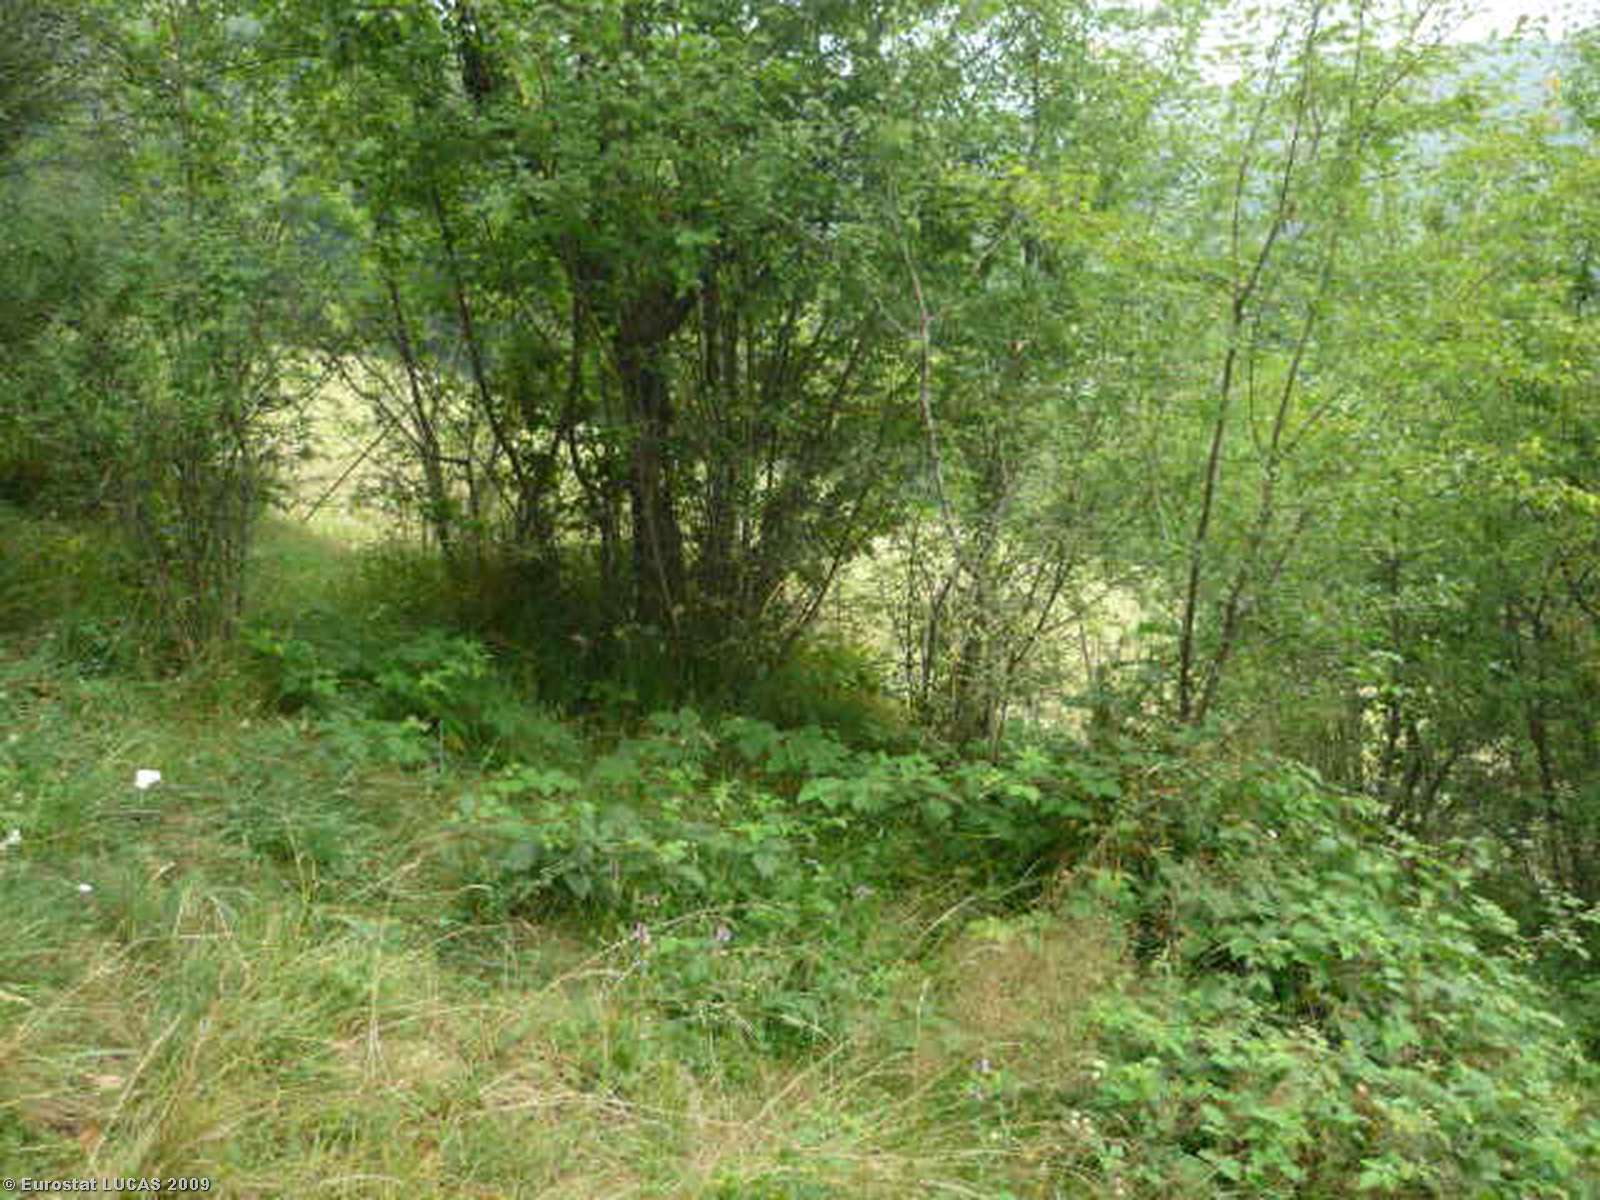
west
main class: Woodland
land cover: Broadleaved woodland
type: thermophilous deciduous forest
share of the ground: > 75 %
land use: Forestry
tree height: > 5 m
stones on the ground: < 10 %
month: July
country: IT
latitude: 45.6314
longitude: 8.0916
